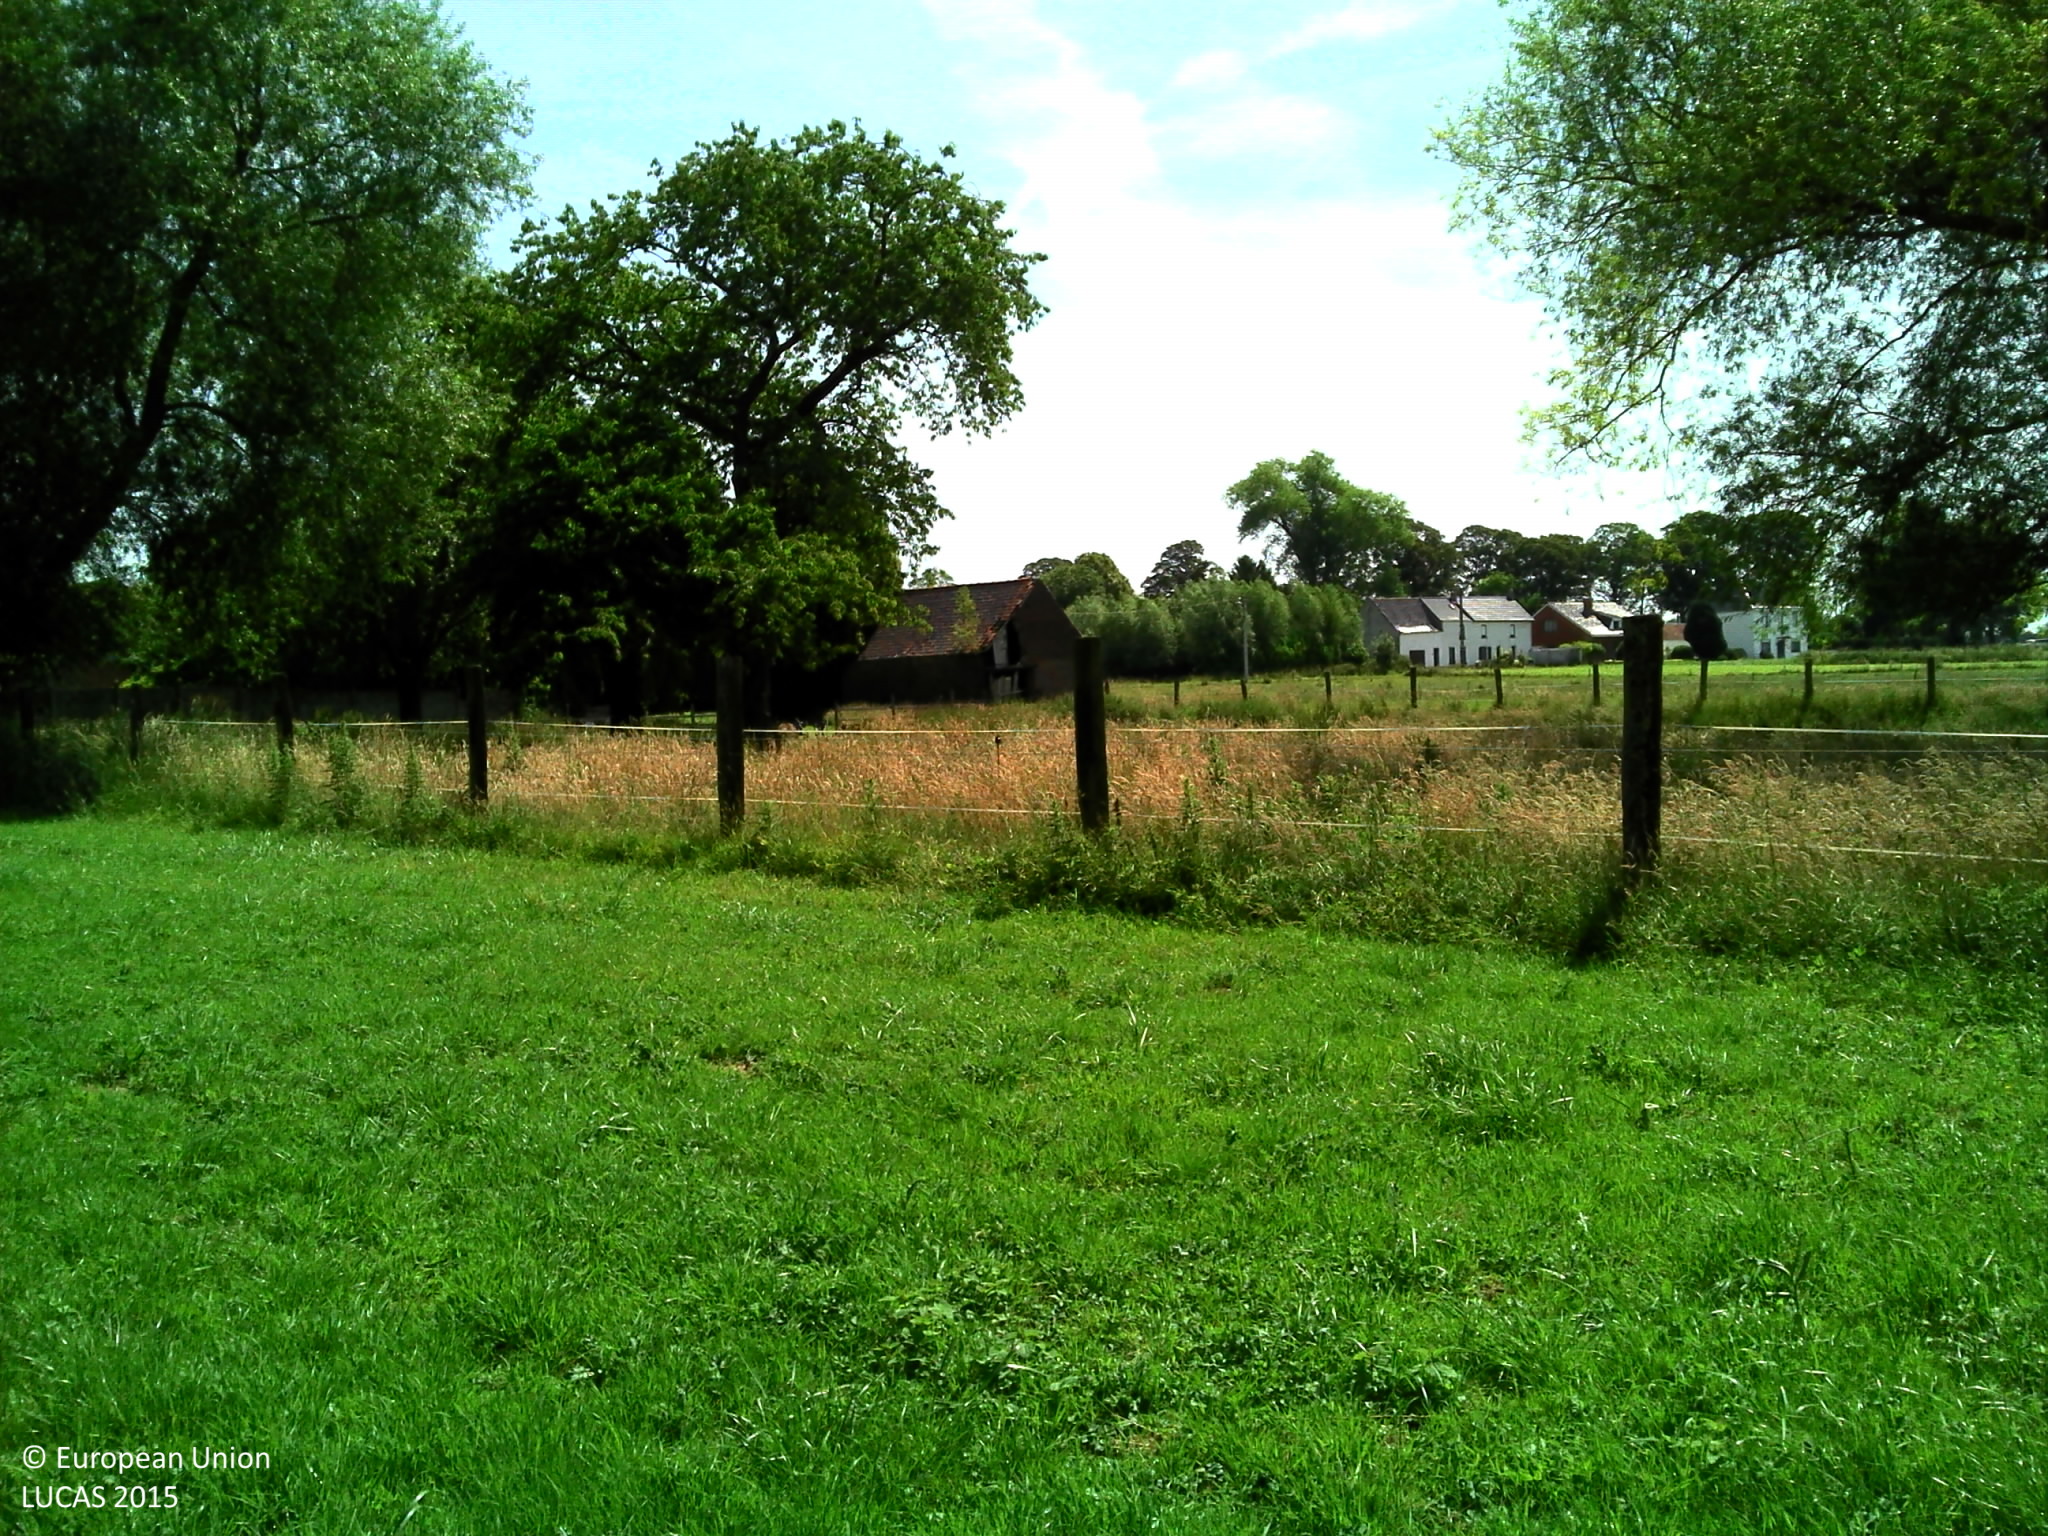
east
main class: Grassland
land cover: Grassland without tree/shrub cover
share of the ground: > 75 %
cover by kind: herbaceous plants 100 %
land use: Agriculture (excluding fallow land and kitchen gardens)
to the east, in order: Grassland without tree/shrub cover; Fences; Grassland with sparse tree/shrub cover; Artificial constructions in urban areas; Grassland without tree/shrub cover; Fences; Electric lines; Grass margins; Paved roads, cycling and walking lanes; Grass margins; Fences; Grassland without tree/shrub cover; Fences; Grassland without tree/shrub cover; Fences; Grass margins; Fences; Grassland without tree/shrub cover
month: June
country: BE
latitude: 50.5456
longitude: 3.6000
